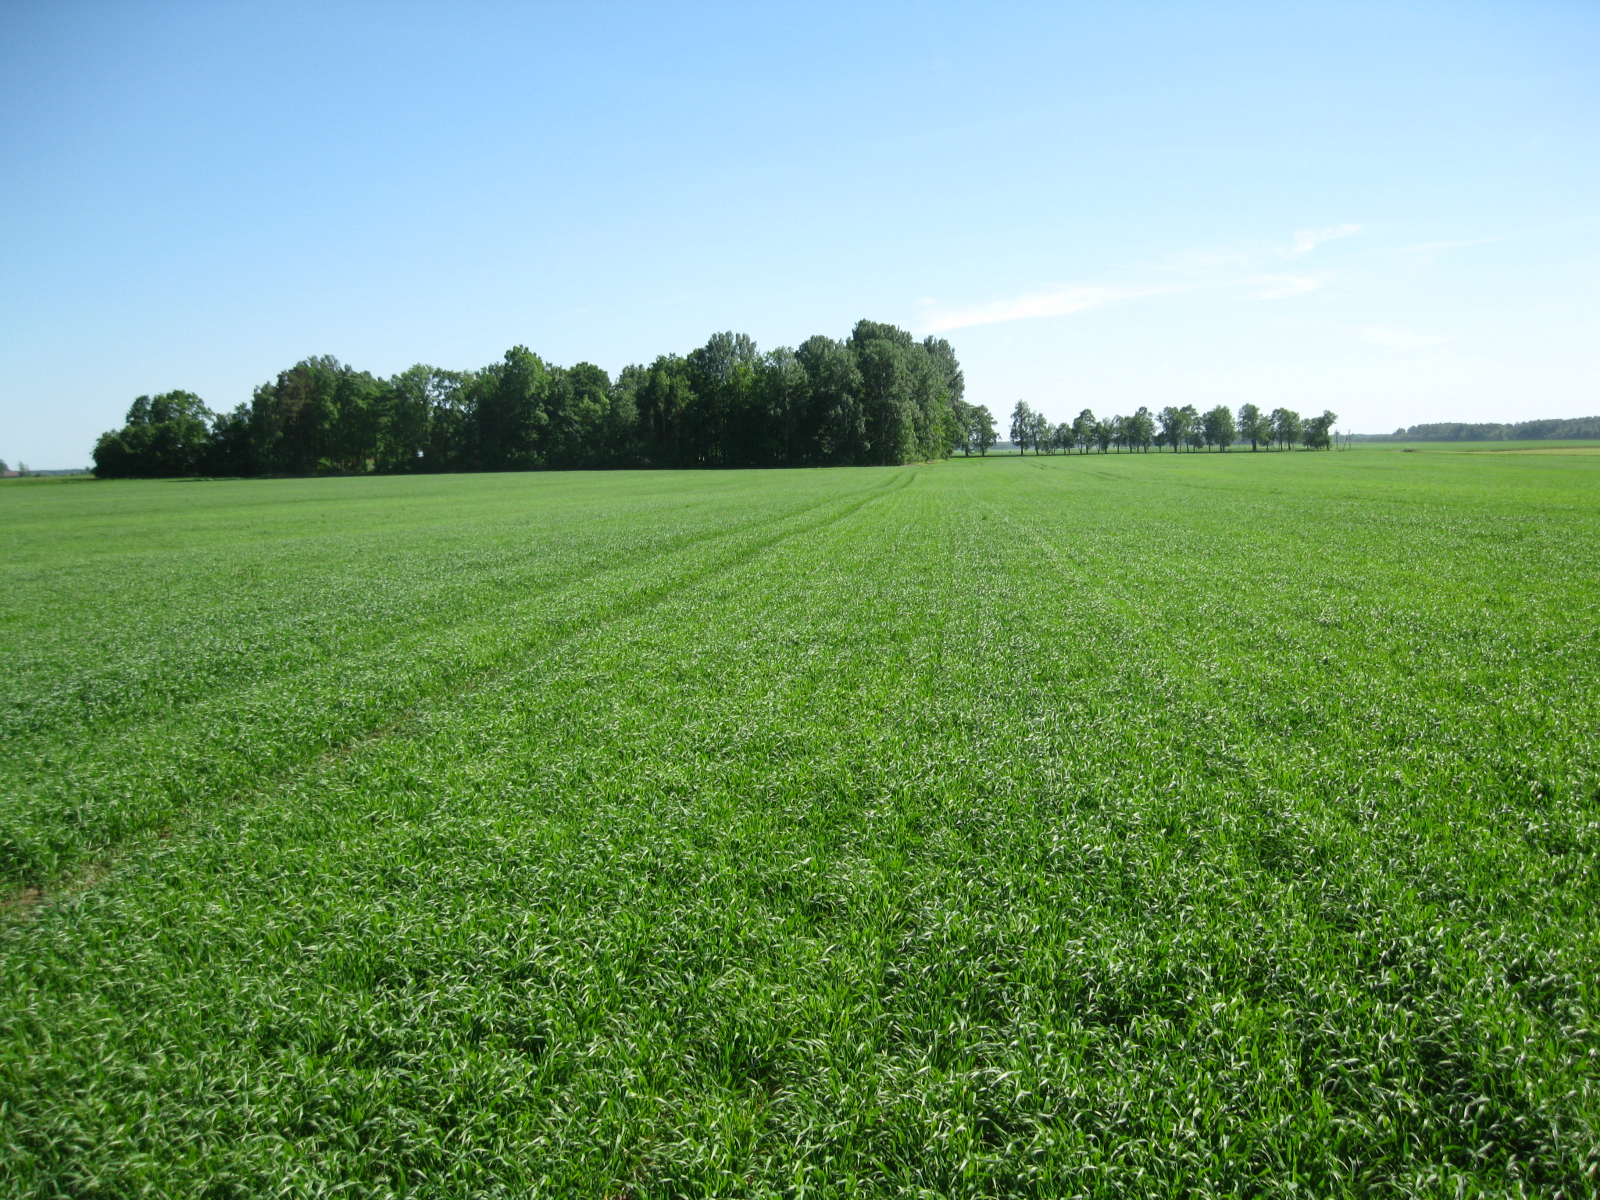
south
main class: Cropland
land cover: Barley
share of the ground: > 75 %
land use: Agriculture (excluding fallow land and kitchen gardens)
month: June
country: LT
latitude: 55.8533
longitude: 23.8383
